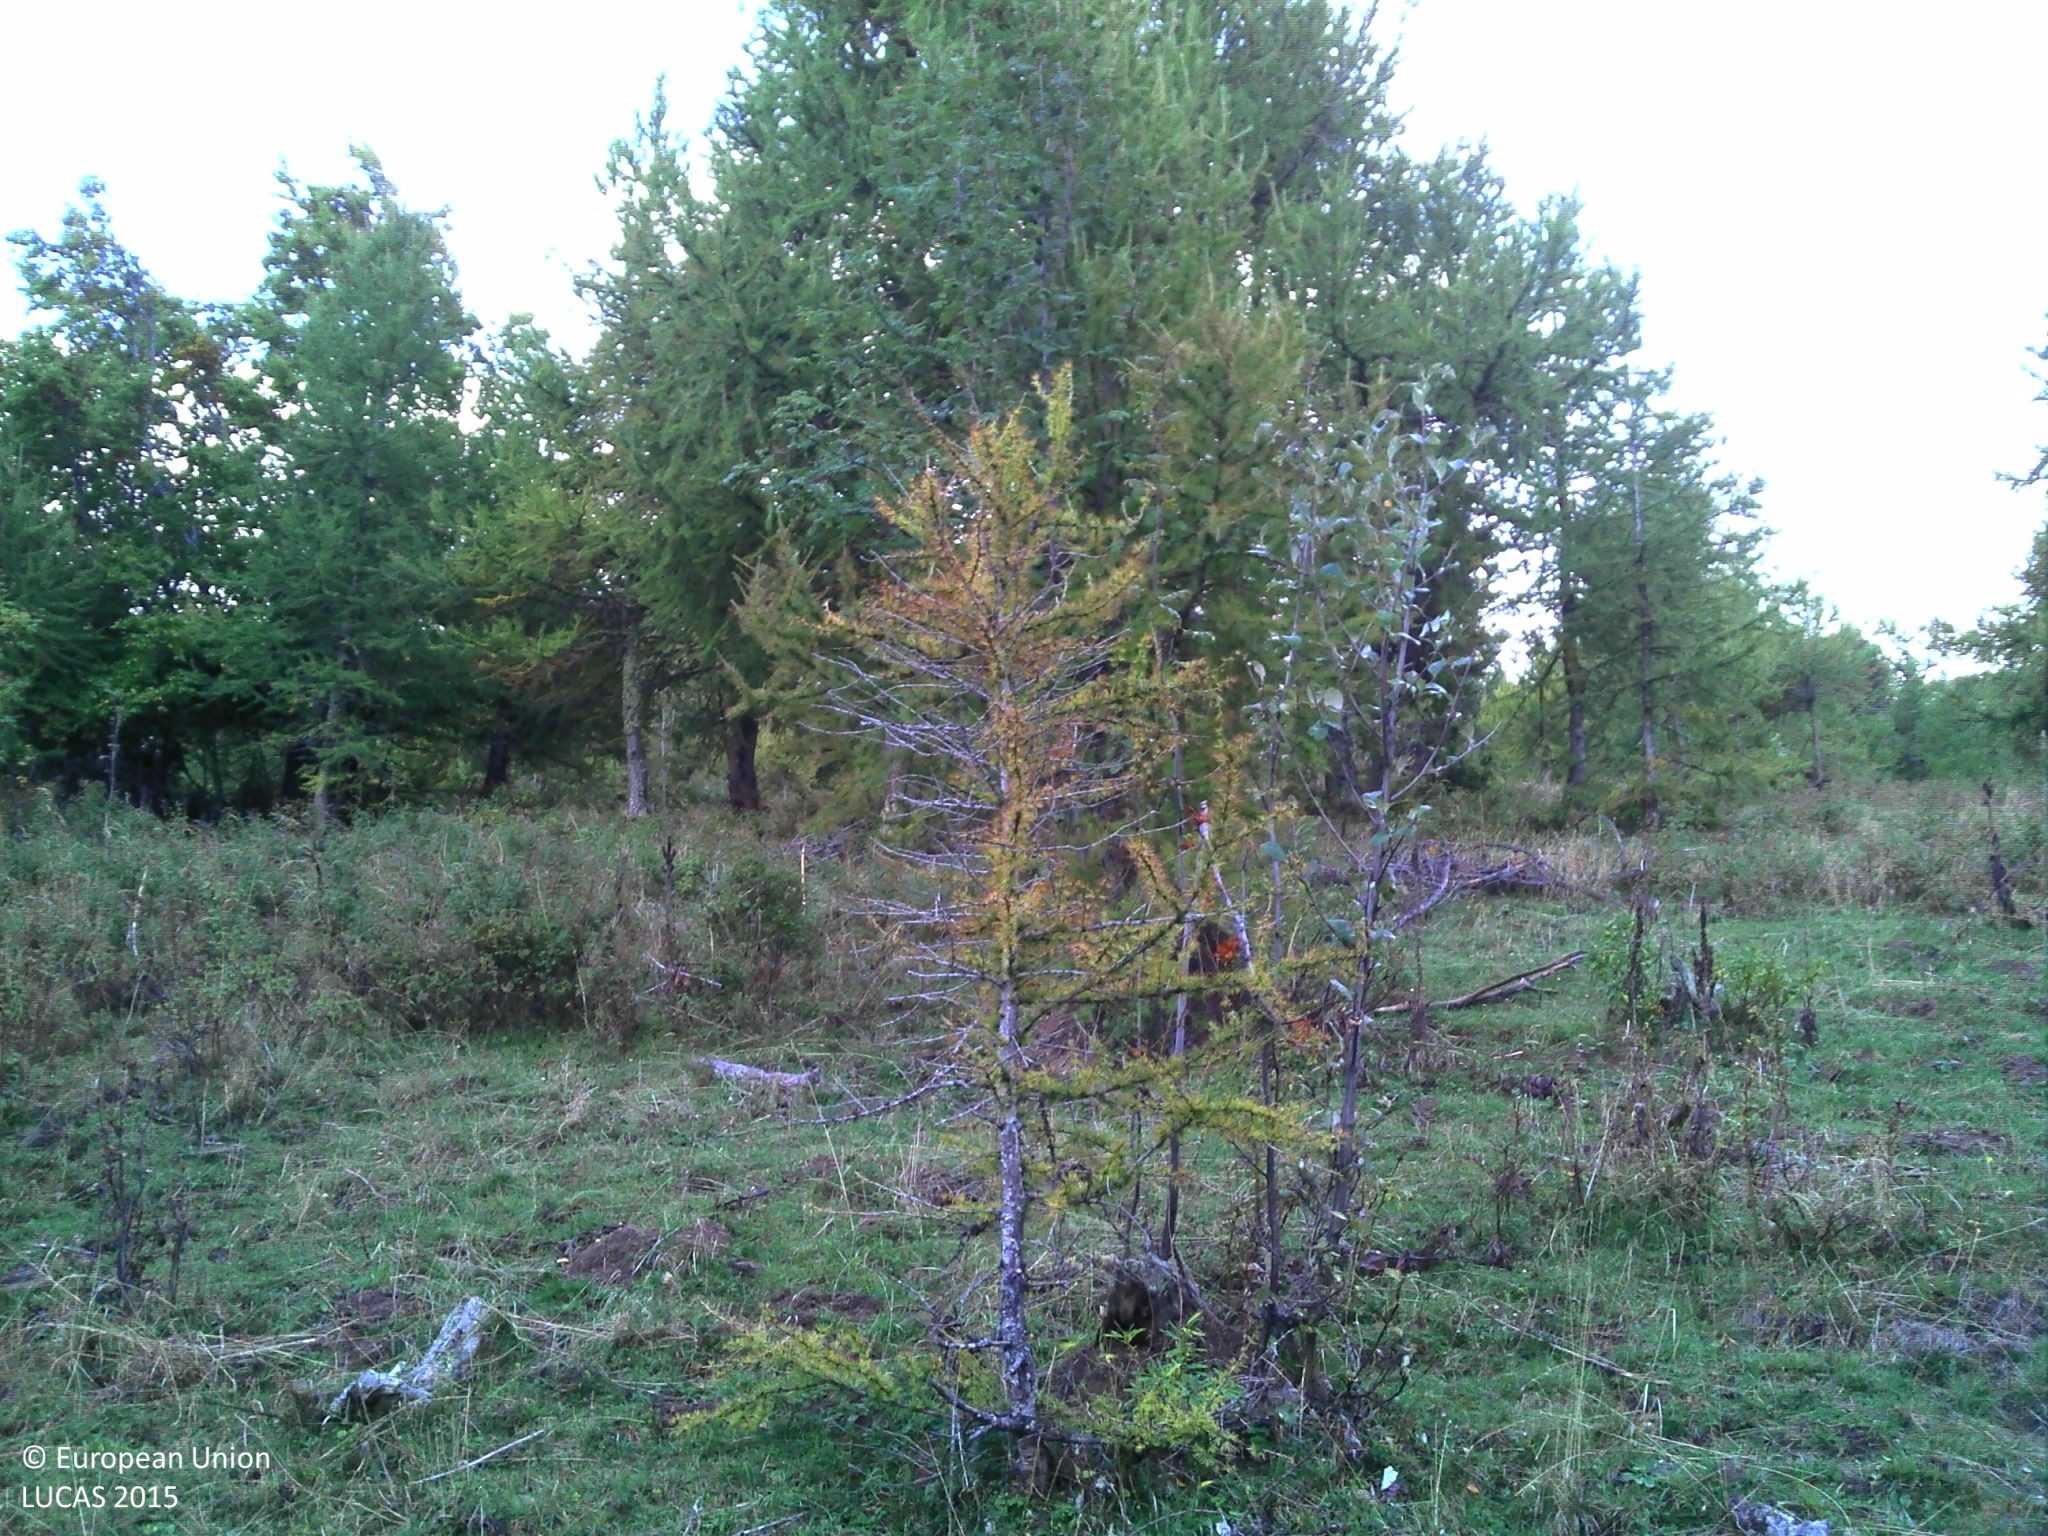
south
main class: Grassland
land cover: Grassland with sparse tree/shrub cover
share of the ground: > 75 %
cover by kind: herbaceous plants 85 %, shrubs 10 %, coniferous forest trees 5 %
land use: Agriculture (excluding fallow land and kitchen gardens)
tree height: > 5 m
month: September
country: FR
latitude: 44.4984
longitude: 6.2211
